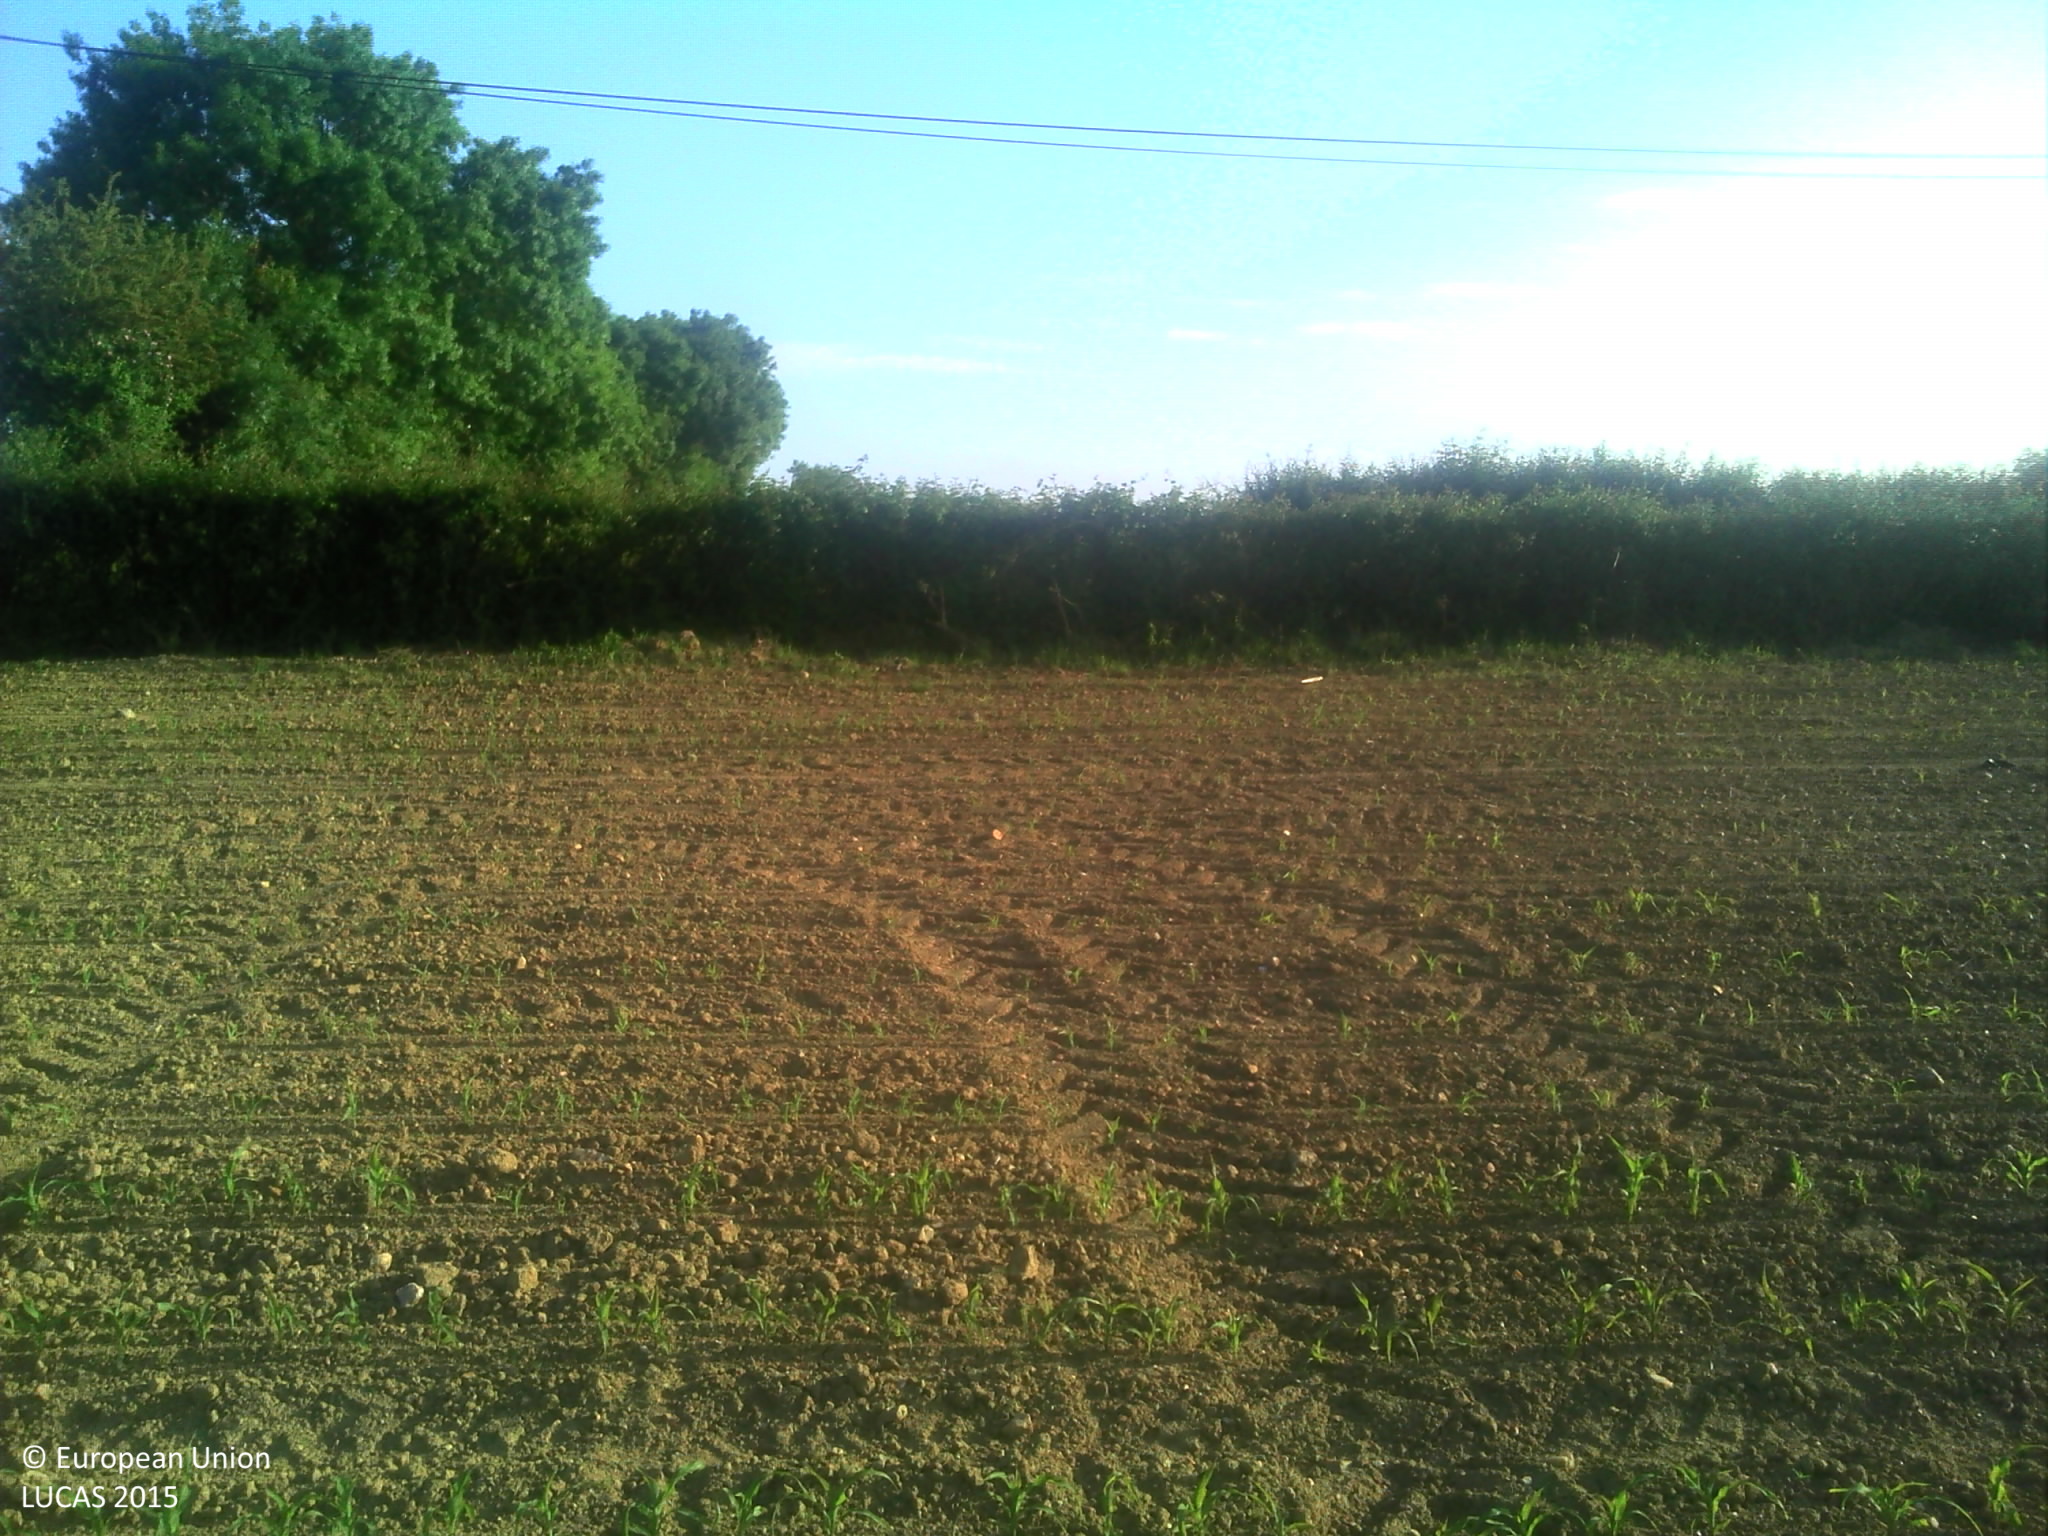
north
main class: Cropland
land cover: Maize
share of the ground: 25 - 50 %
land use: Agriculture (excluding fallow land and kitchen gardens)
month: May
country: FR
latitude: 47.4324
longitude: -1.0277
